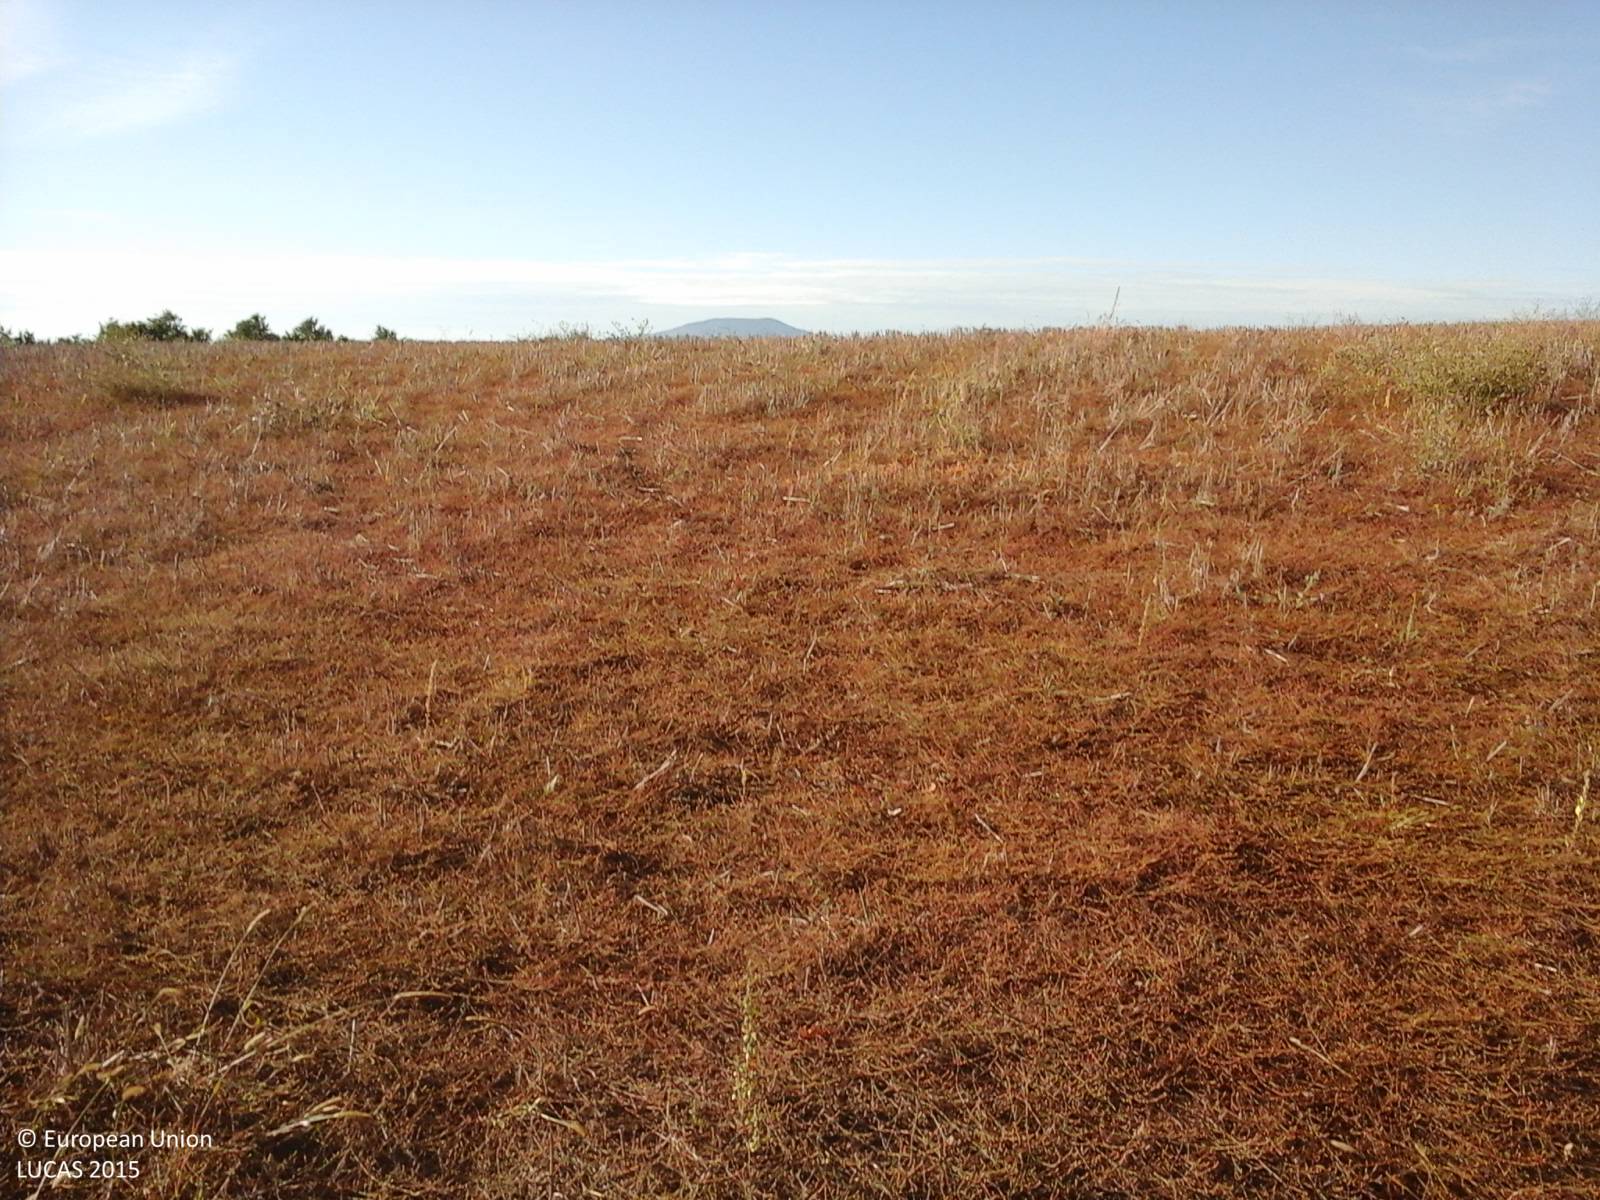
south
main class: Cropland
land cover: Durum wheat
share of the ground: < 10 %
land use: Agriculture (excluding fallow land and kitchen gardens)
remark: Harvested field
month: September
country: IT
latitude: 42.5574
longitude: 12.2216
